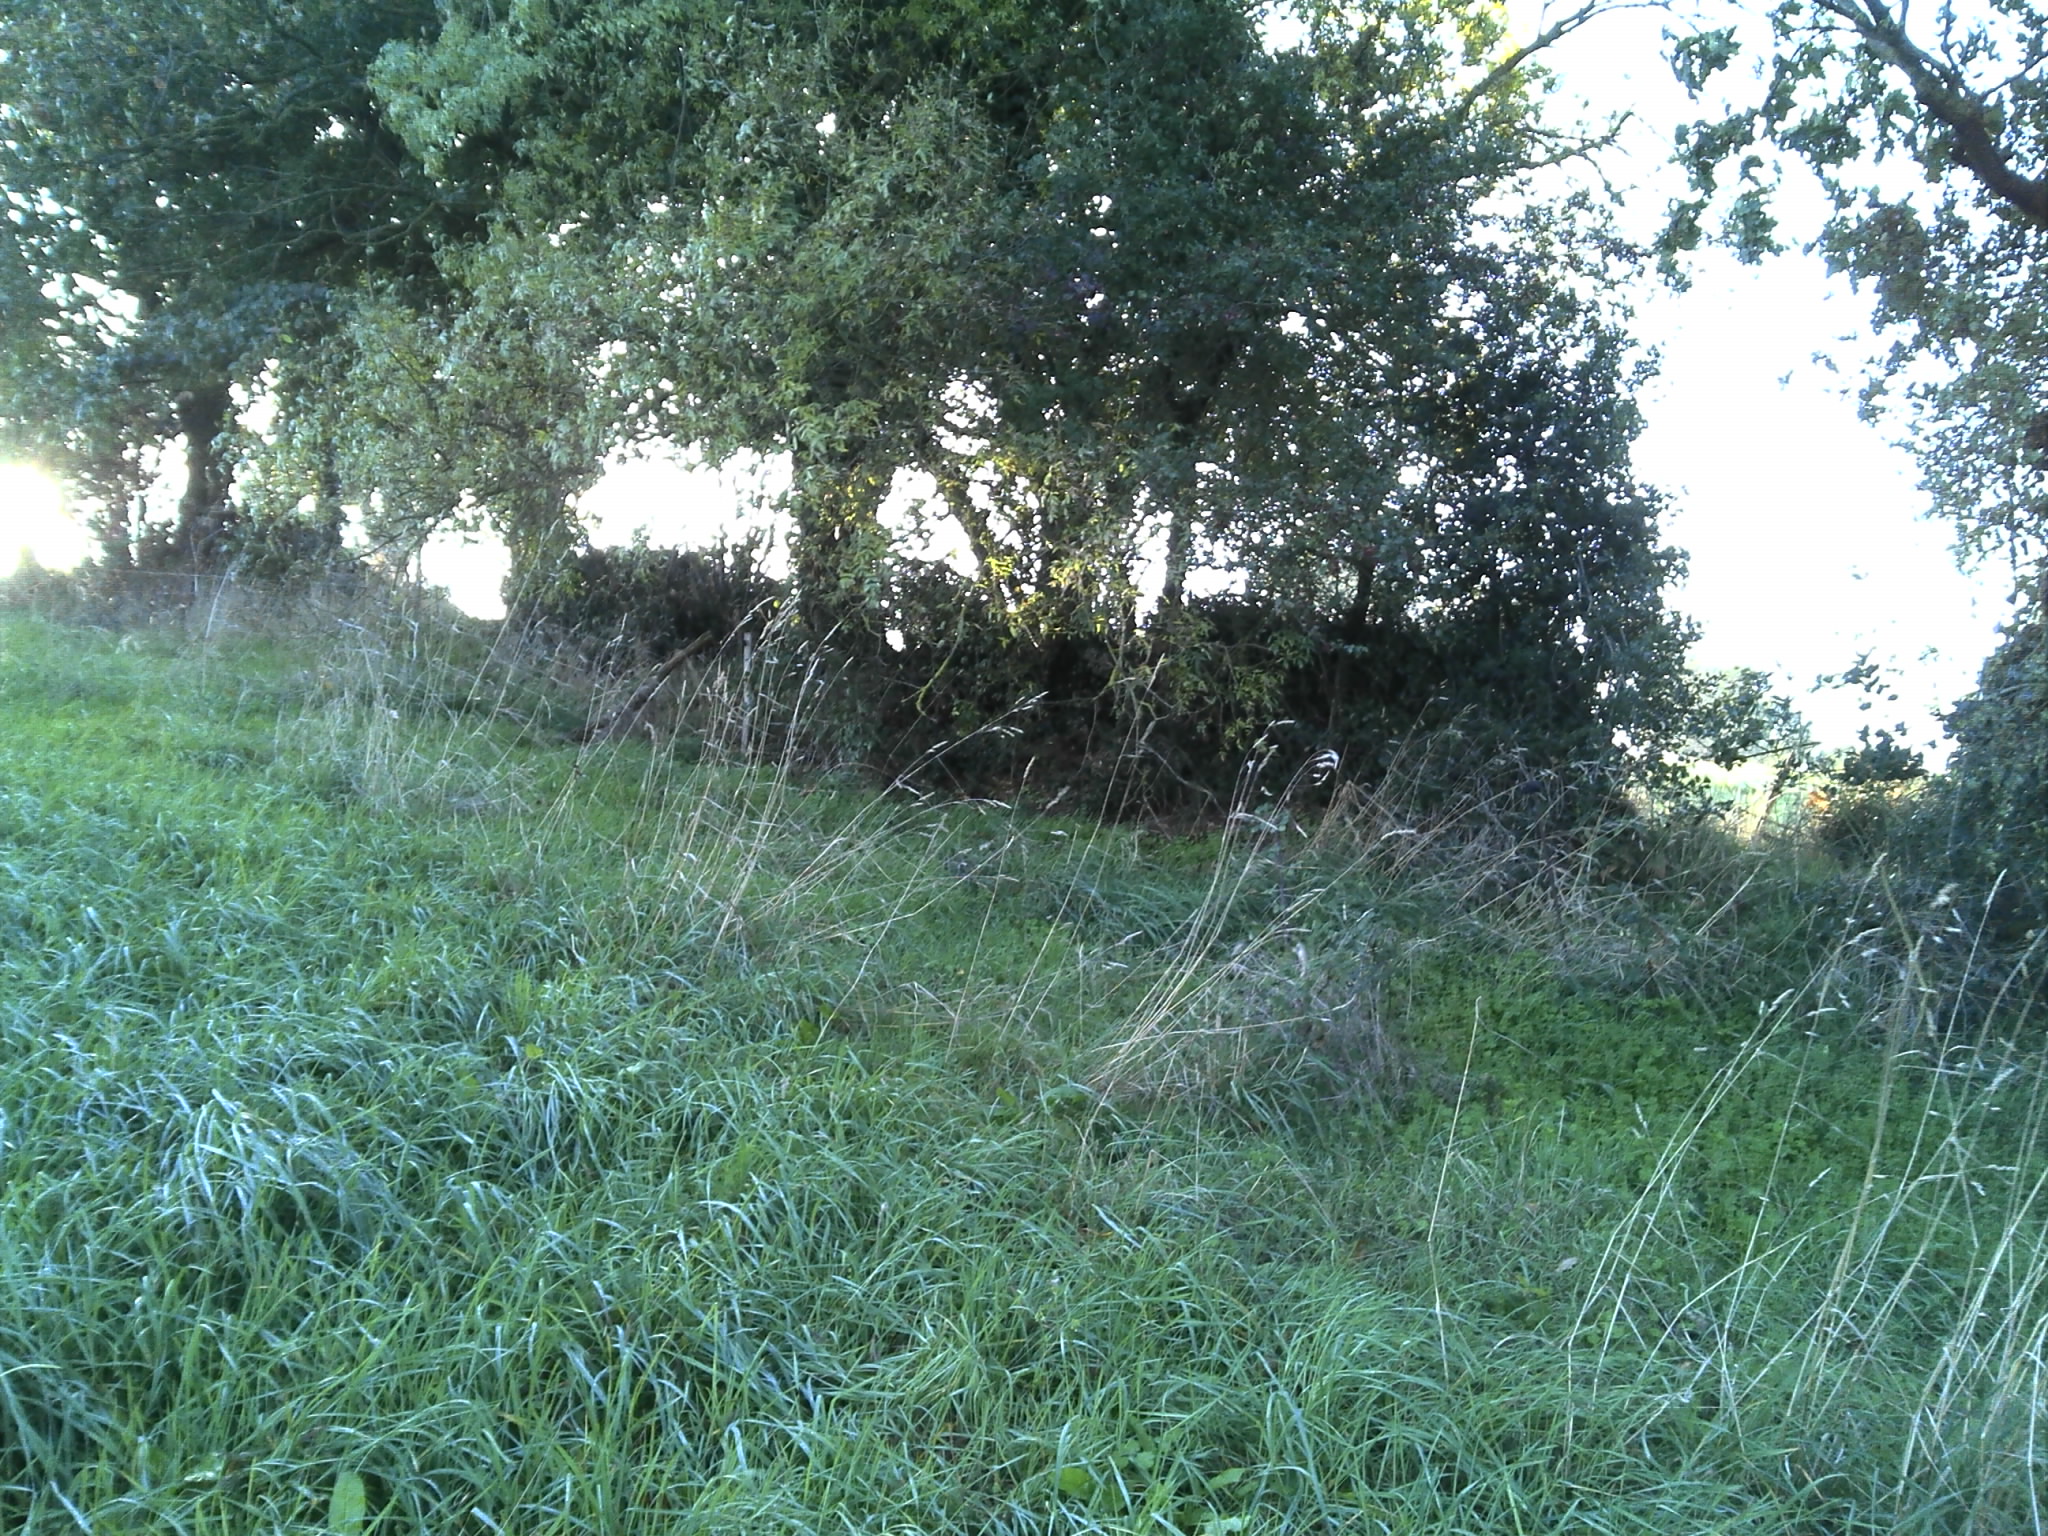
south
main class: Grassland
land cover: Grassland without tree/shrub cover
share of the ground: > 75 %
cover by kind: herbaceous plants 100 %
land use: Agriculture (excluding fallow land and kitchen gardens)
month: October
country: FR
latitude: 47.3462
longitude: -0.9825
